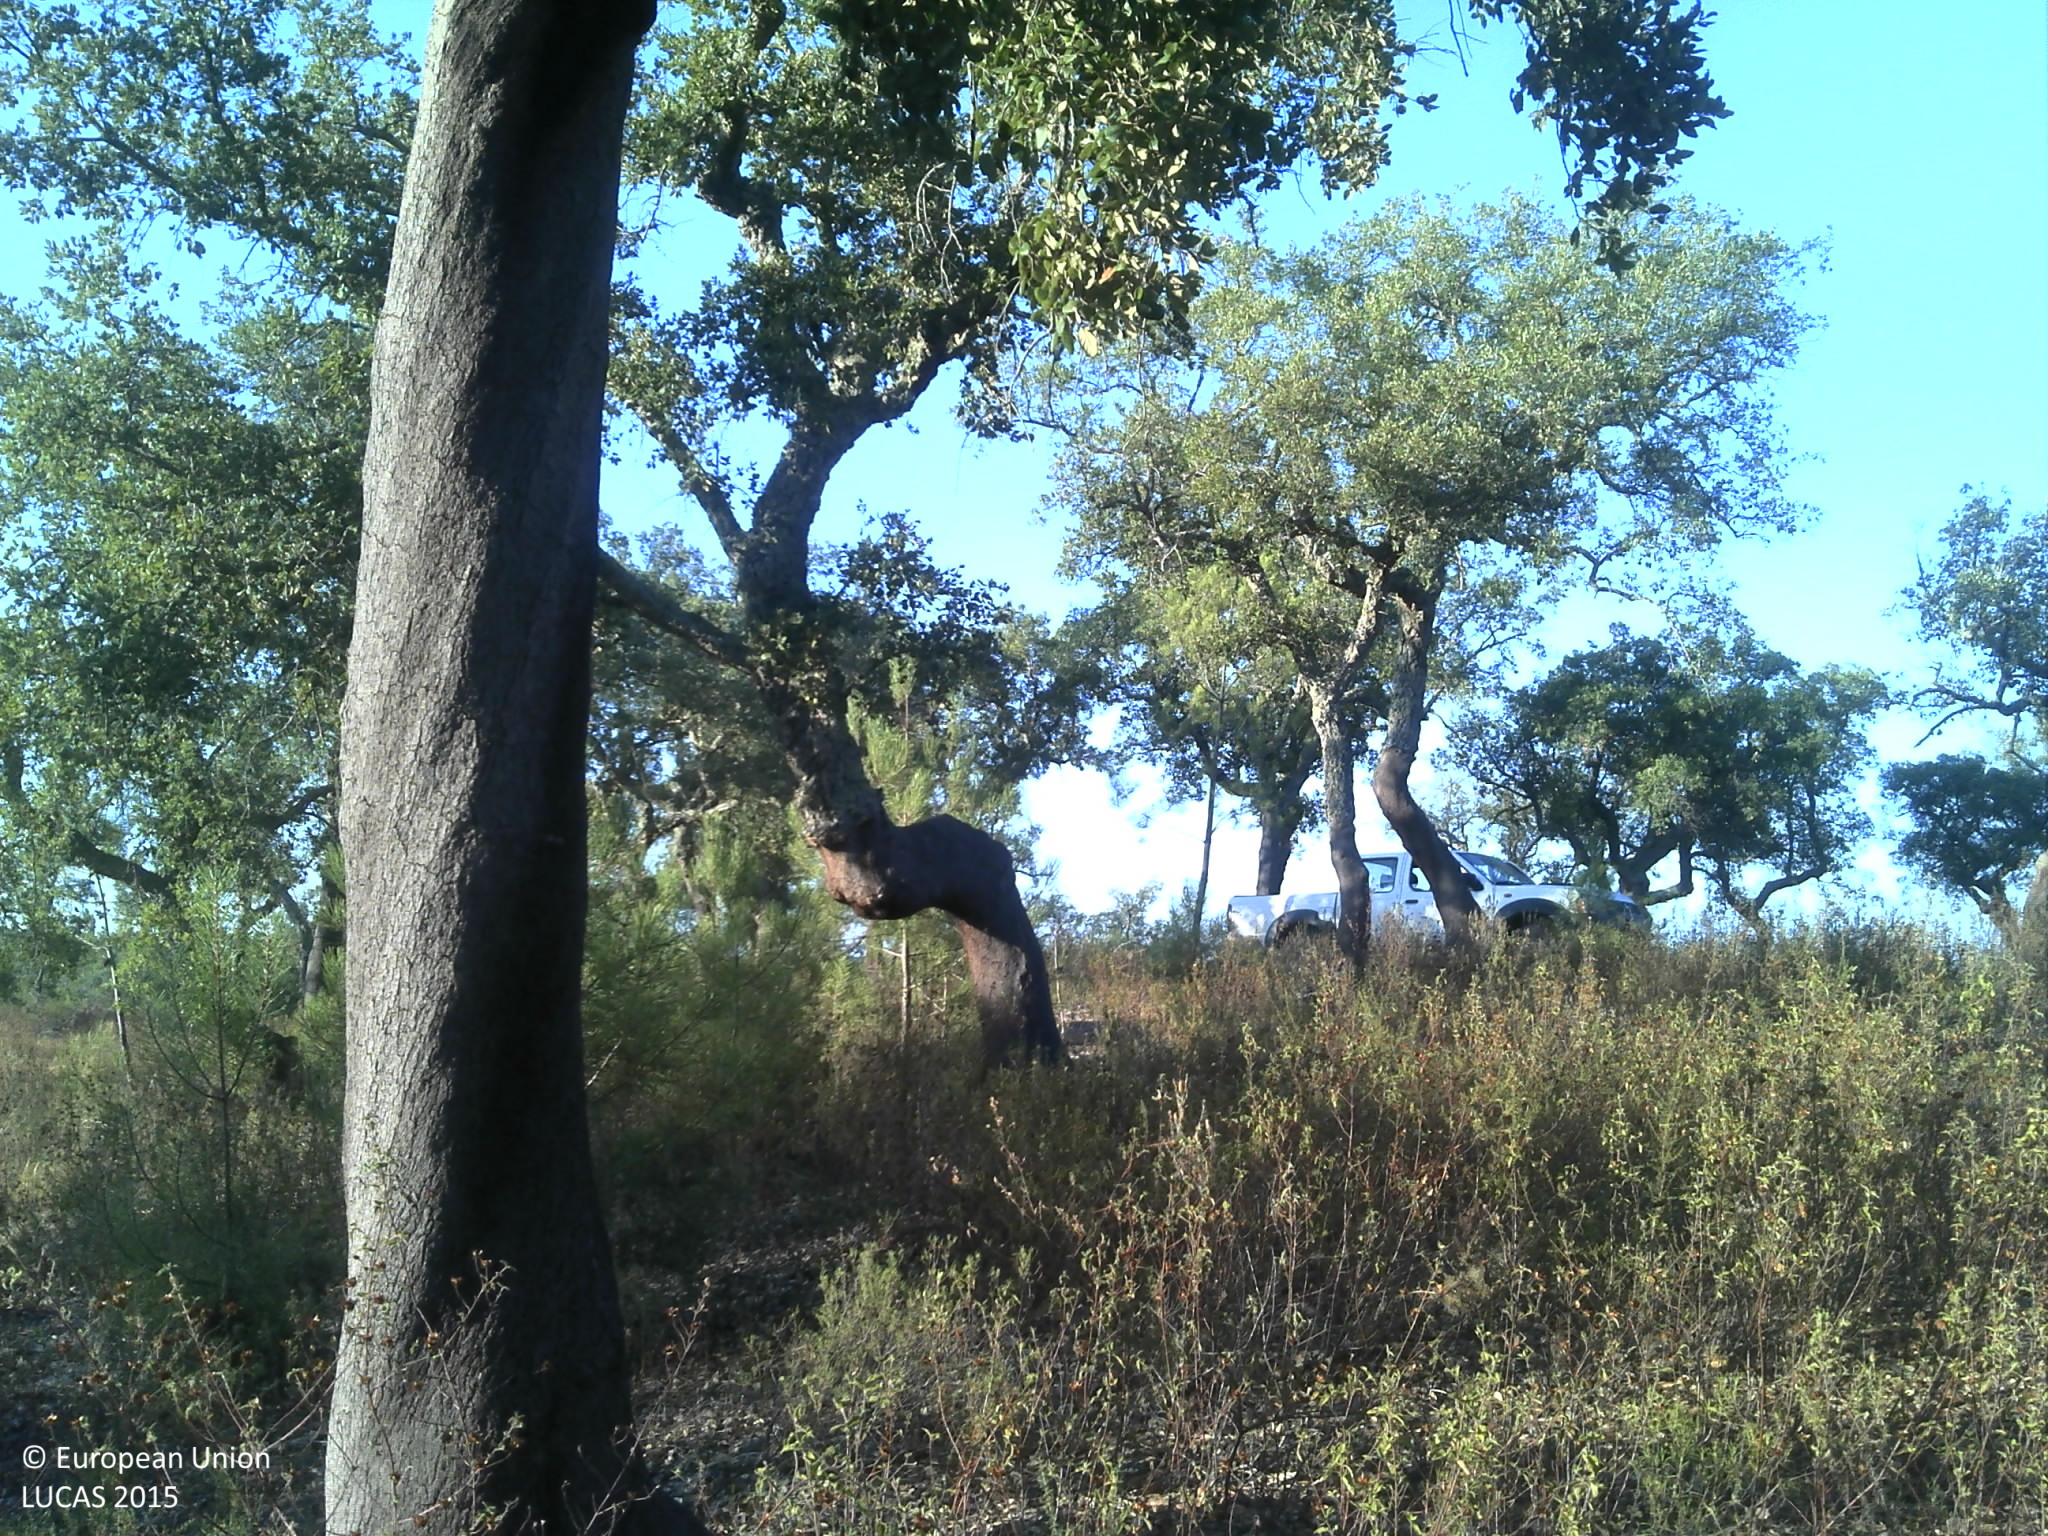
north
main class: Woodland
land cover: Broadleaved woodland
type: broadleaved evergreen forest
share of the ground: 25 - 50 %
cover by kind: broadleaved forest trees 50 %, unconsolidated bare surface 25 %, herbaceous plants 15 %, shrubs 10 %
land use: Forestry
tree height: > 5 m
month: July
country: PT
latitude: 38.9370
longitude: -8.2007
